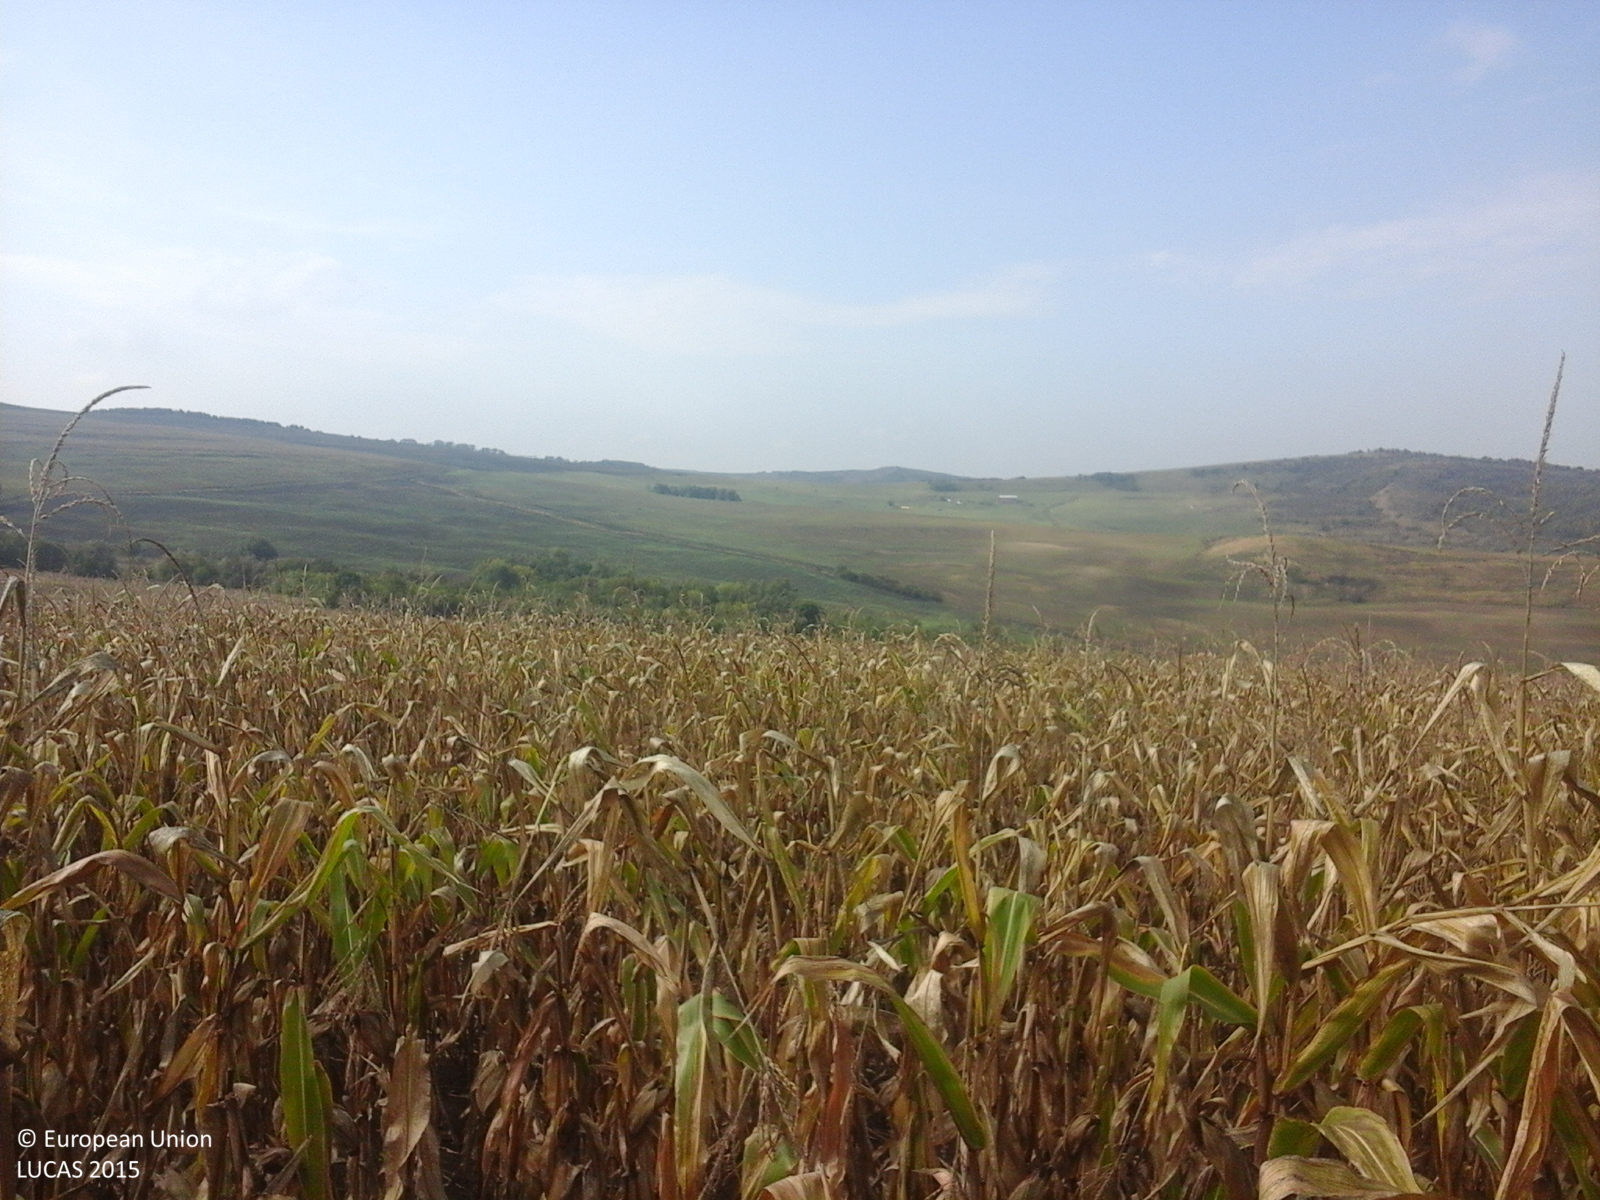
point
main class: Cropland
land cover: Maize
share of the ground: > 75 %
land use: Agriculture (excluding fallow land and kitchen gardens)
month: October
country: RO
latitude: 46.3692
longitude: 24.3162
